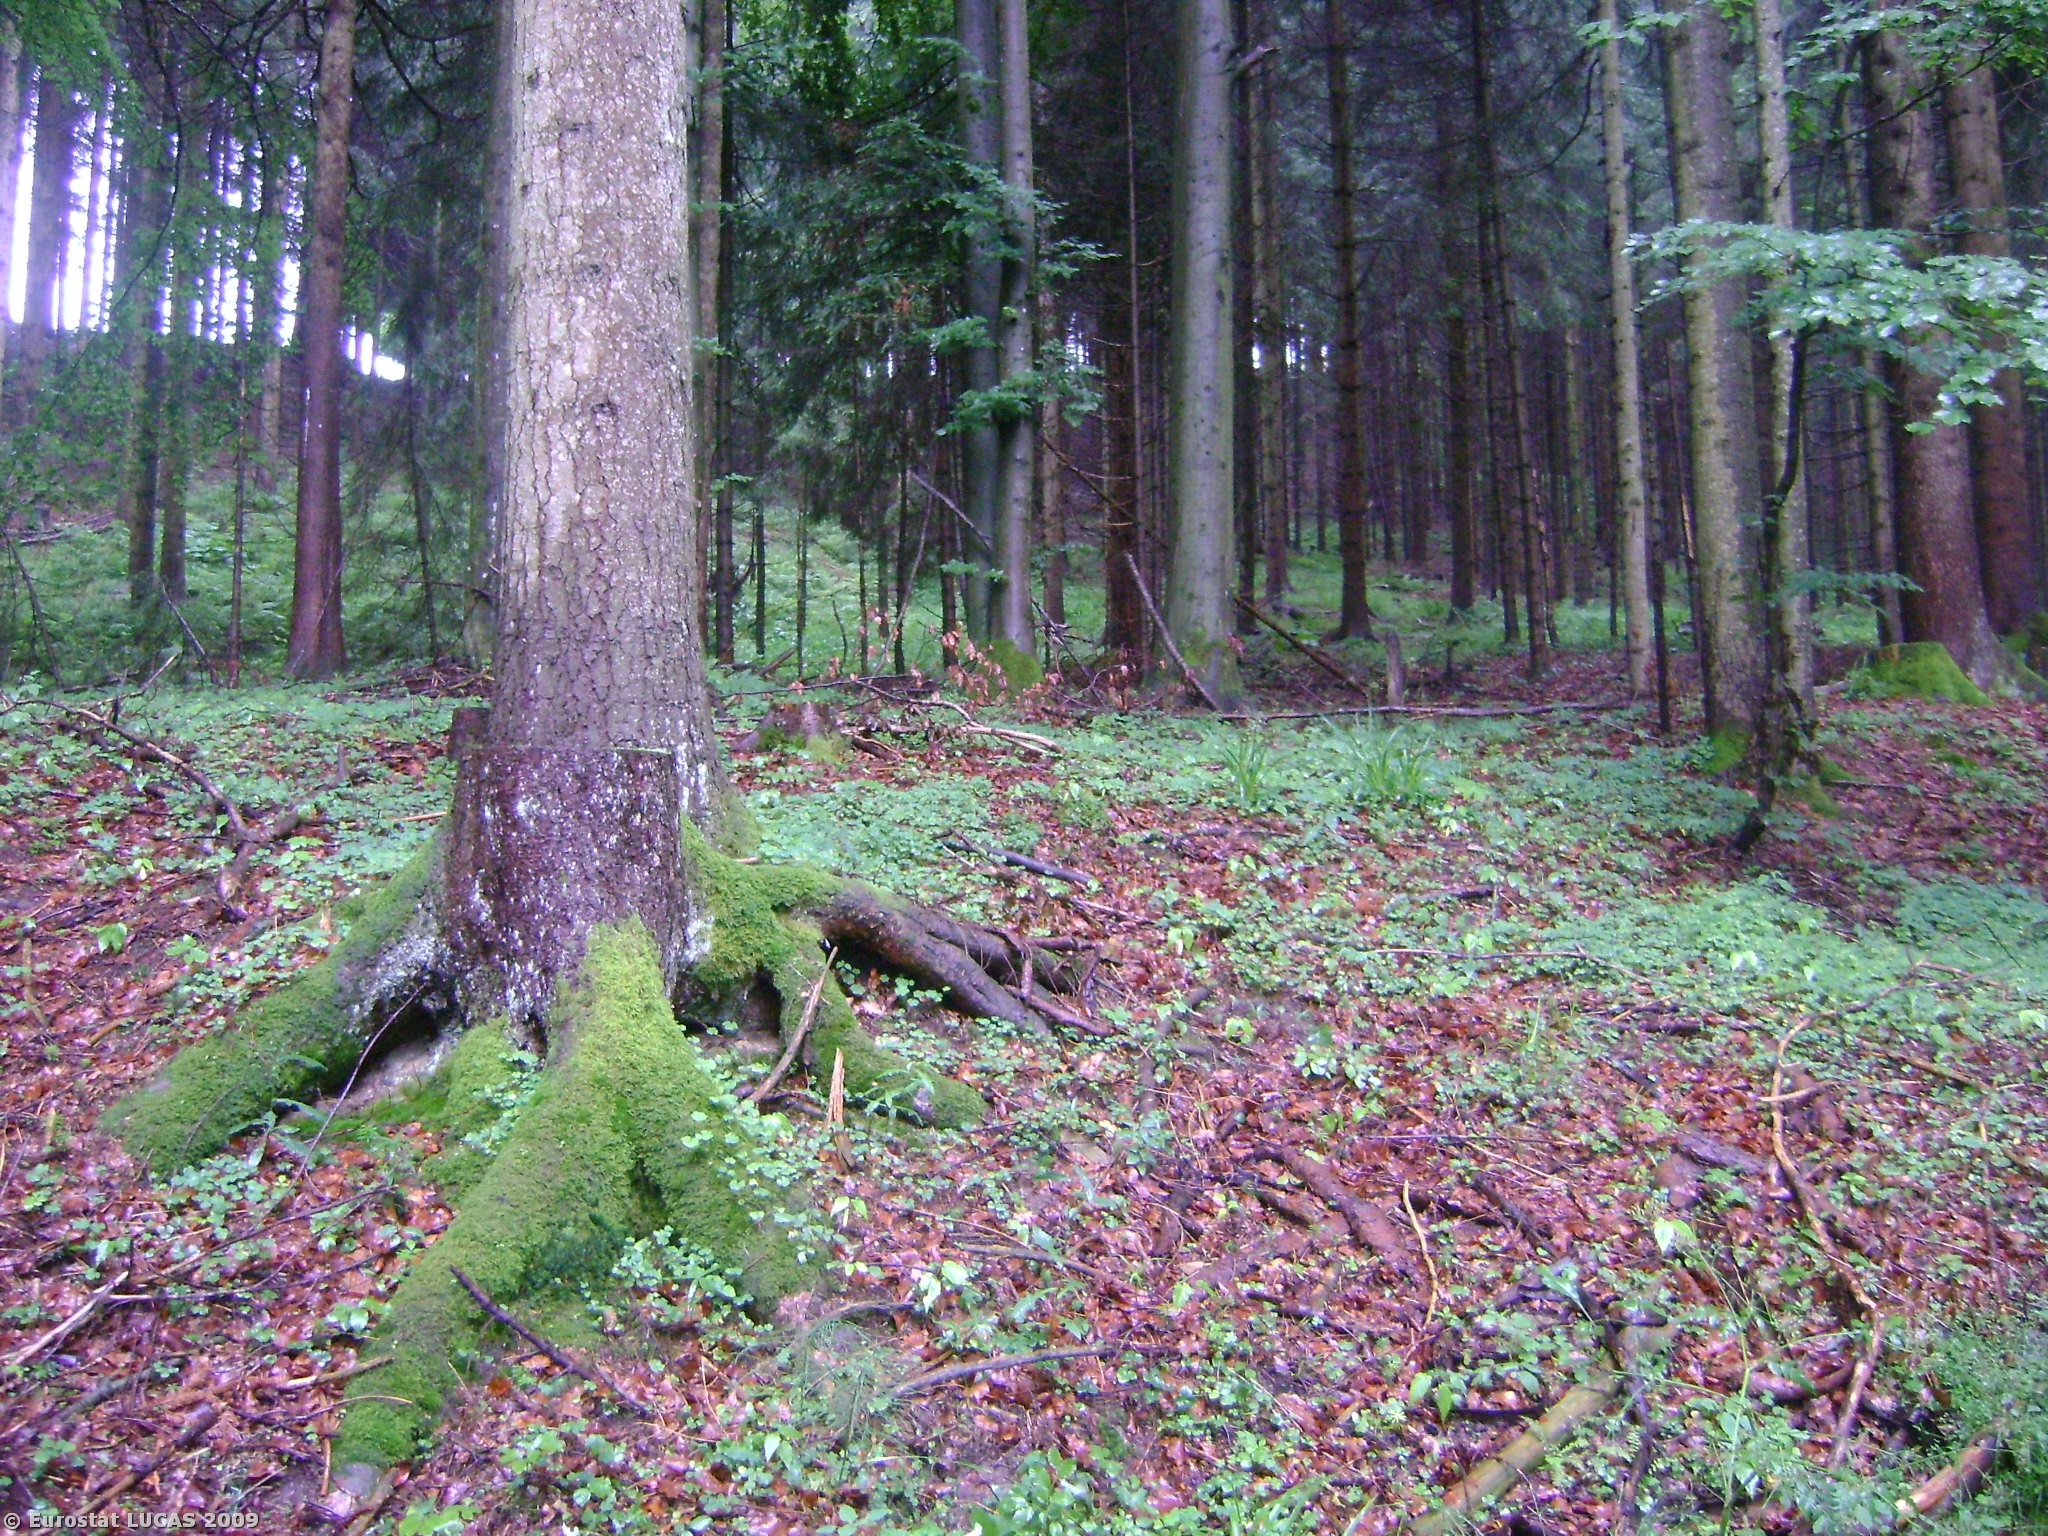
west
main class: Woodland
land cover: Coniferous woodland
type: hemiboreal forest and nemoral coniferous forest and mixed broadleaved-coniferous forest
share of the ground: > 75 %
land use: Forestry
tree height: > 5 m
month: June
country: AT
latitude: 47.8696
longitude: 13.2474
